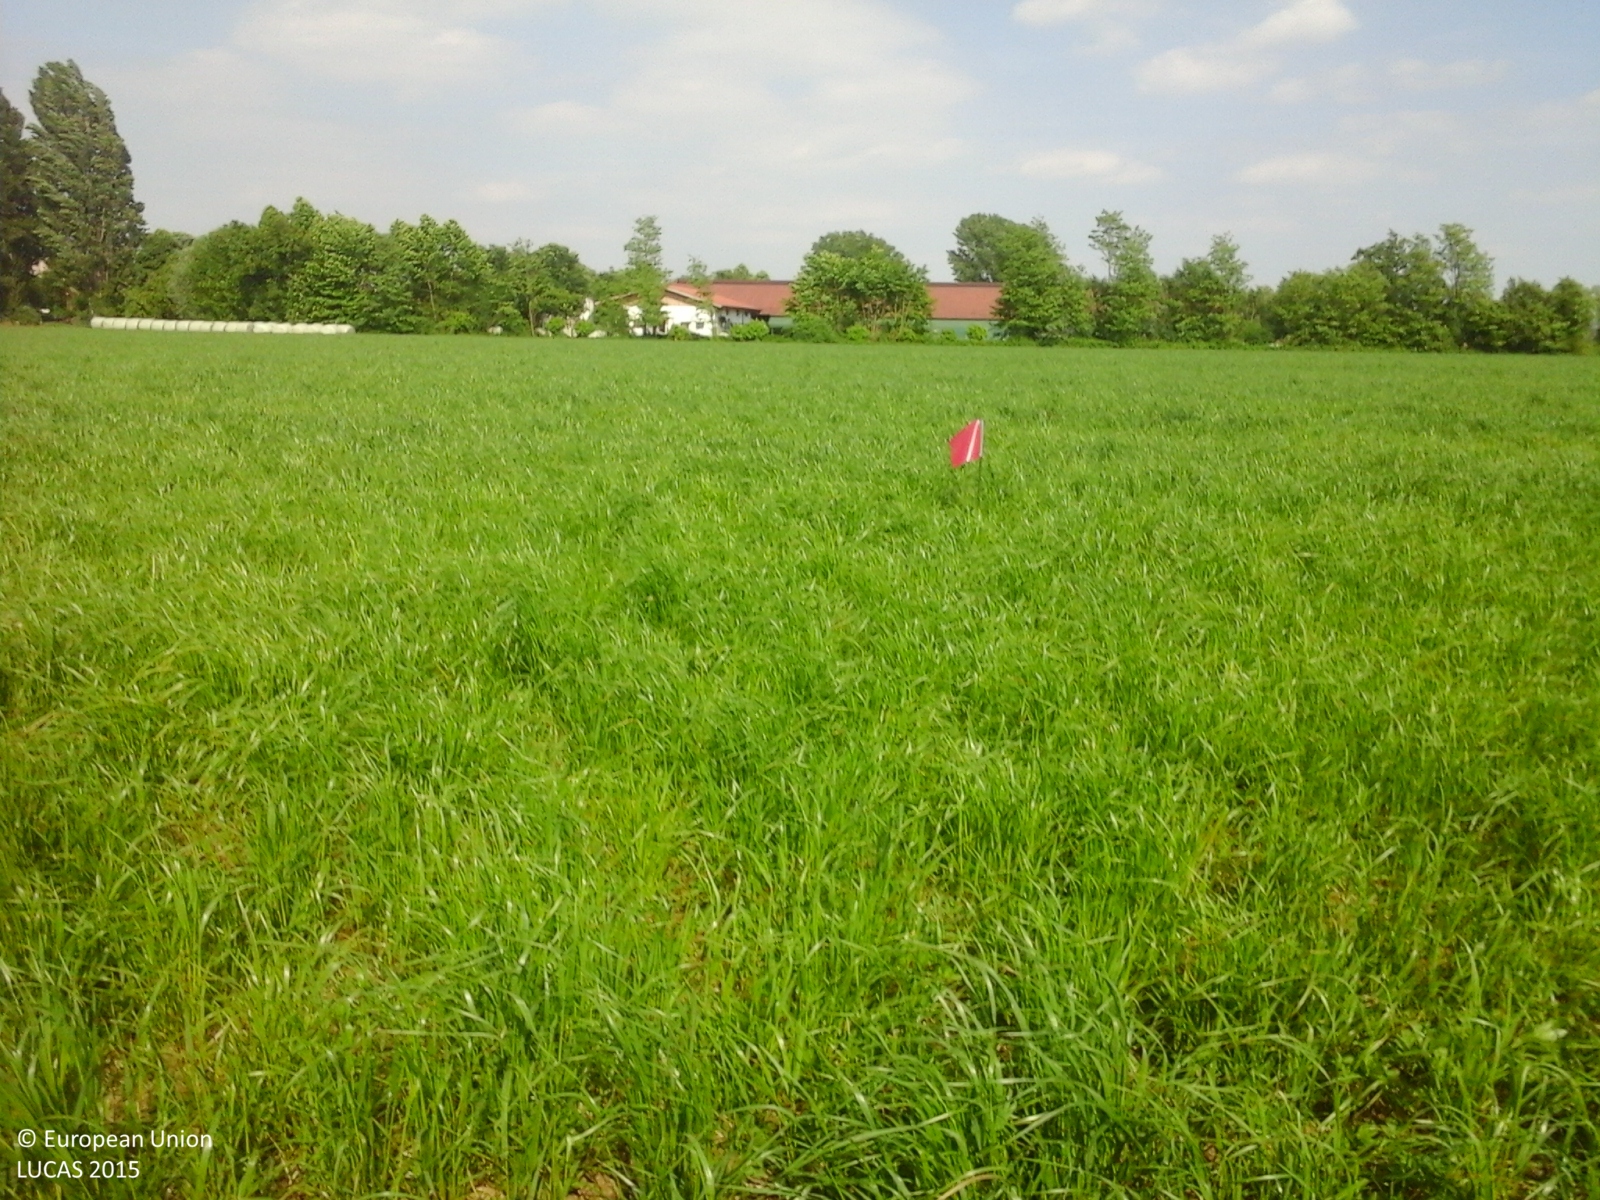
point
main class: Grassland
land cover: Spontaneously vegetated surfaces
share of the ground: > 75 %
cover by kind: herbaceous plants 100 %
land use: Agriculture (excluding fallow land and kitchen gardens)
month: May
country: IT
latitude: 45.6012
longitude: 11.5488
